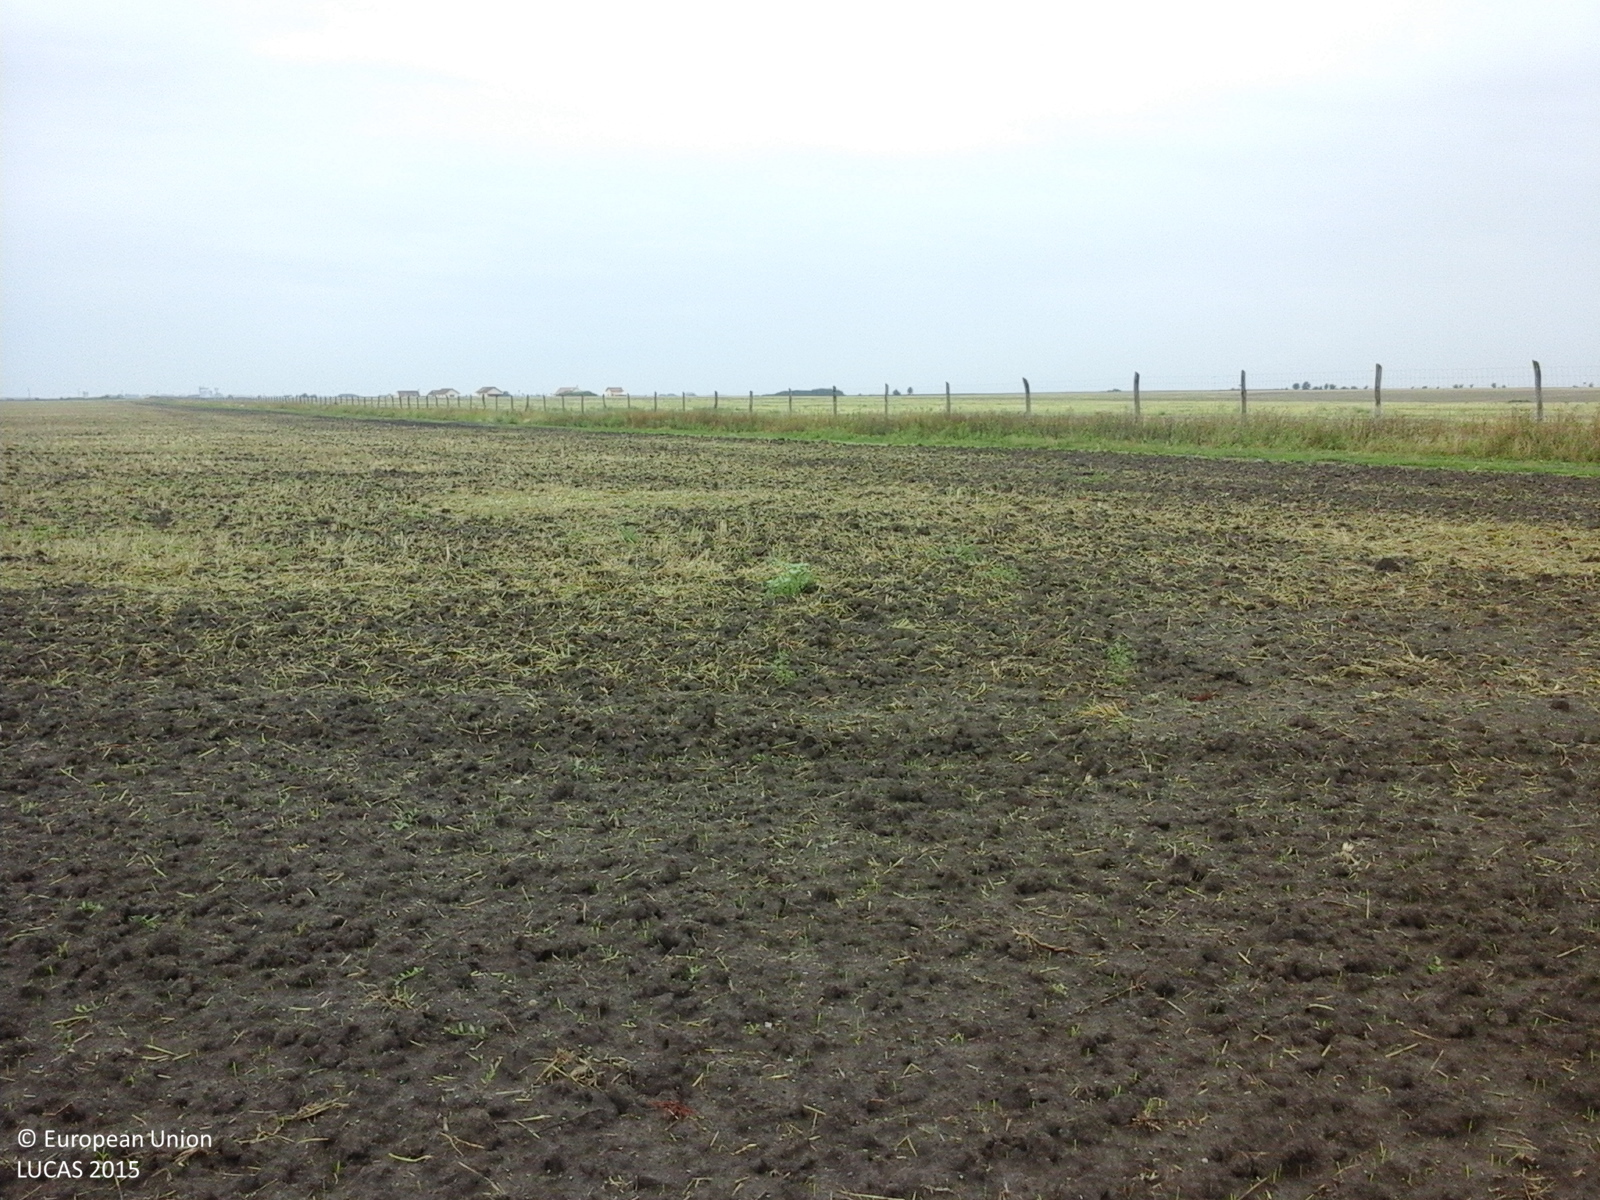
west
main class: Cropland
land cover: Maize
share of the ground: > 75 %
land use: Agriculture (excluding fallow land and kitchen gardens)
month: August
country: RO
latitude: 45.4516
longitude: 21.3723
